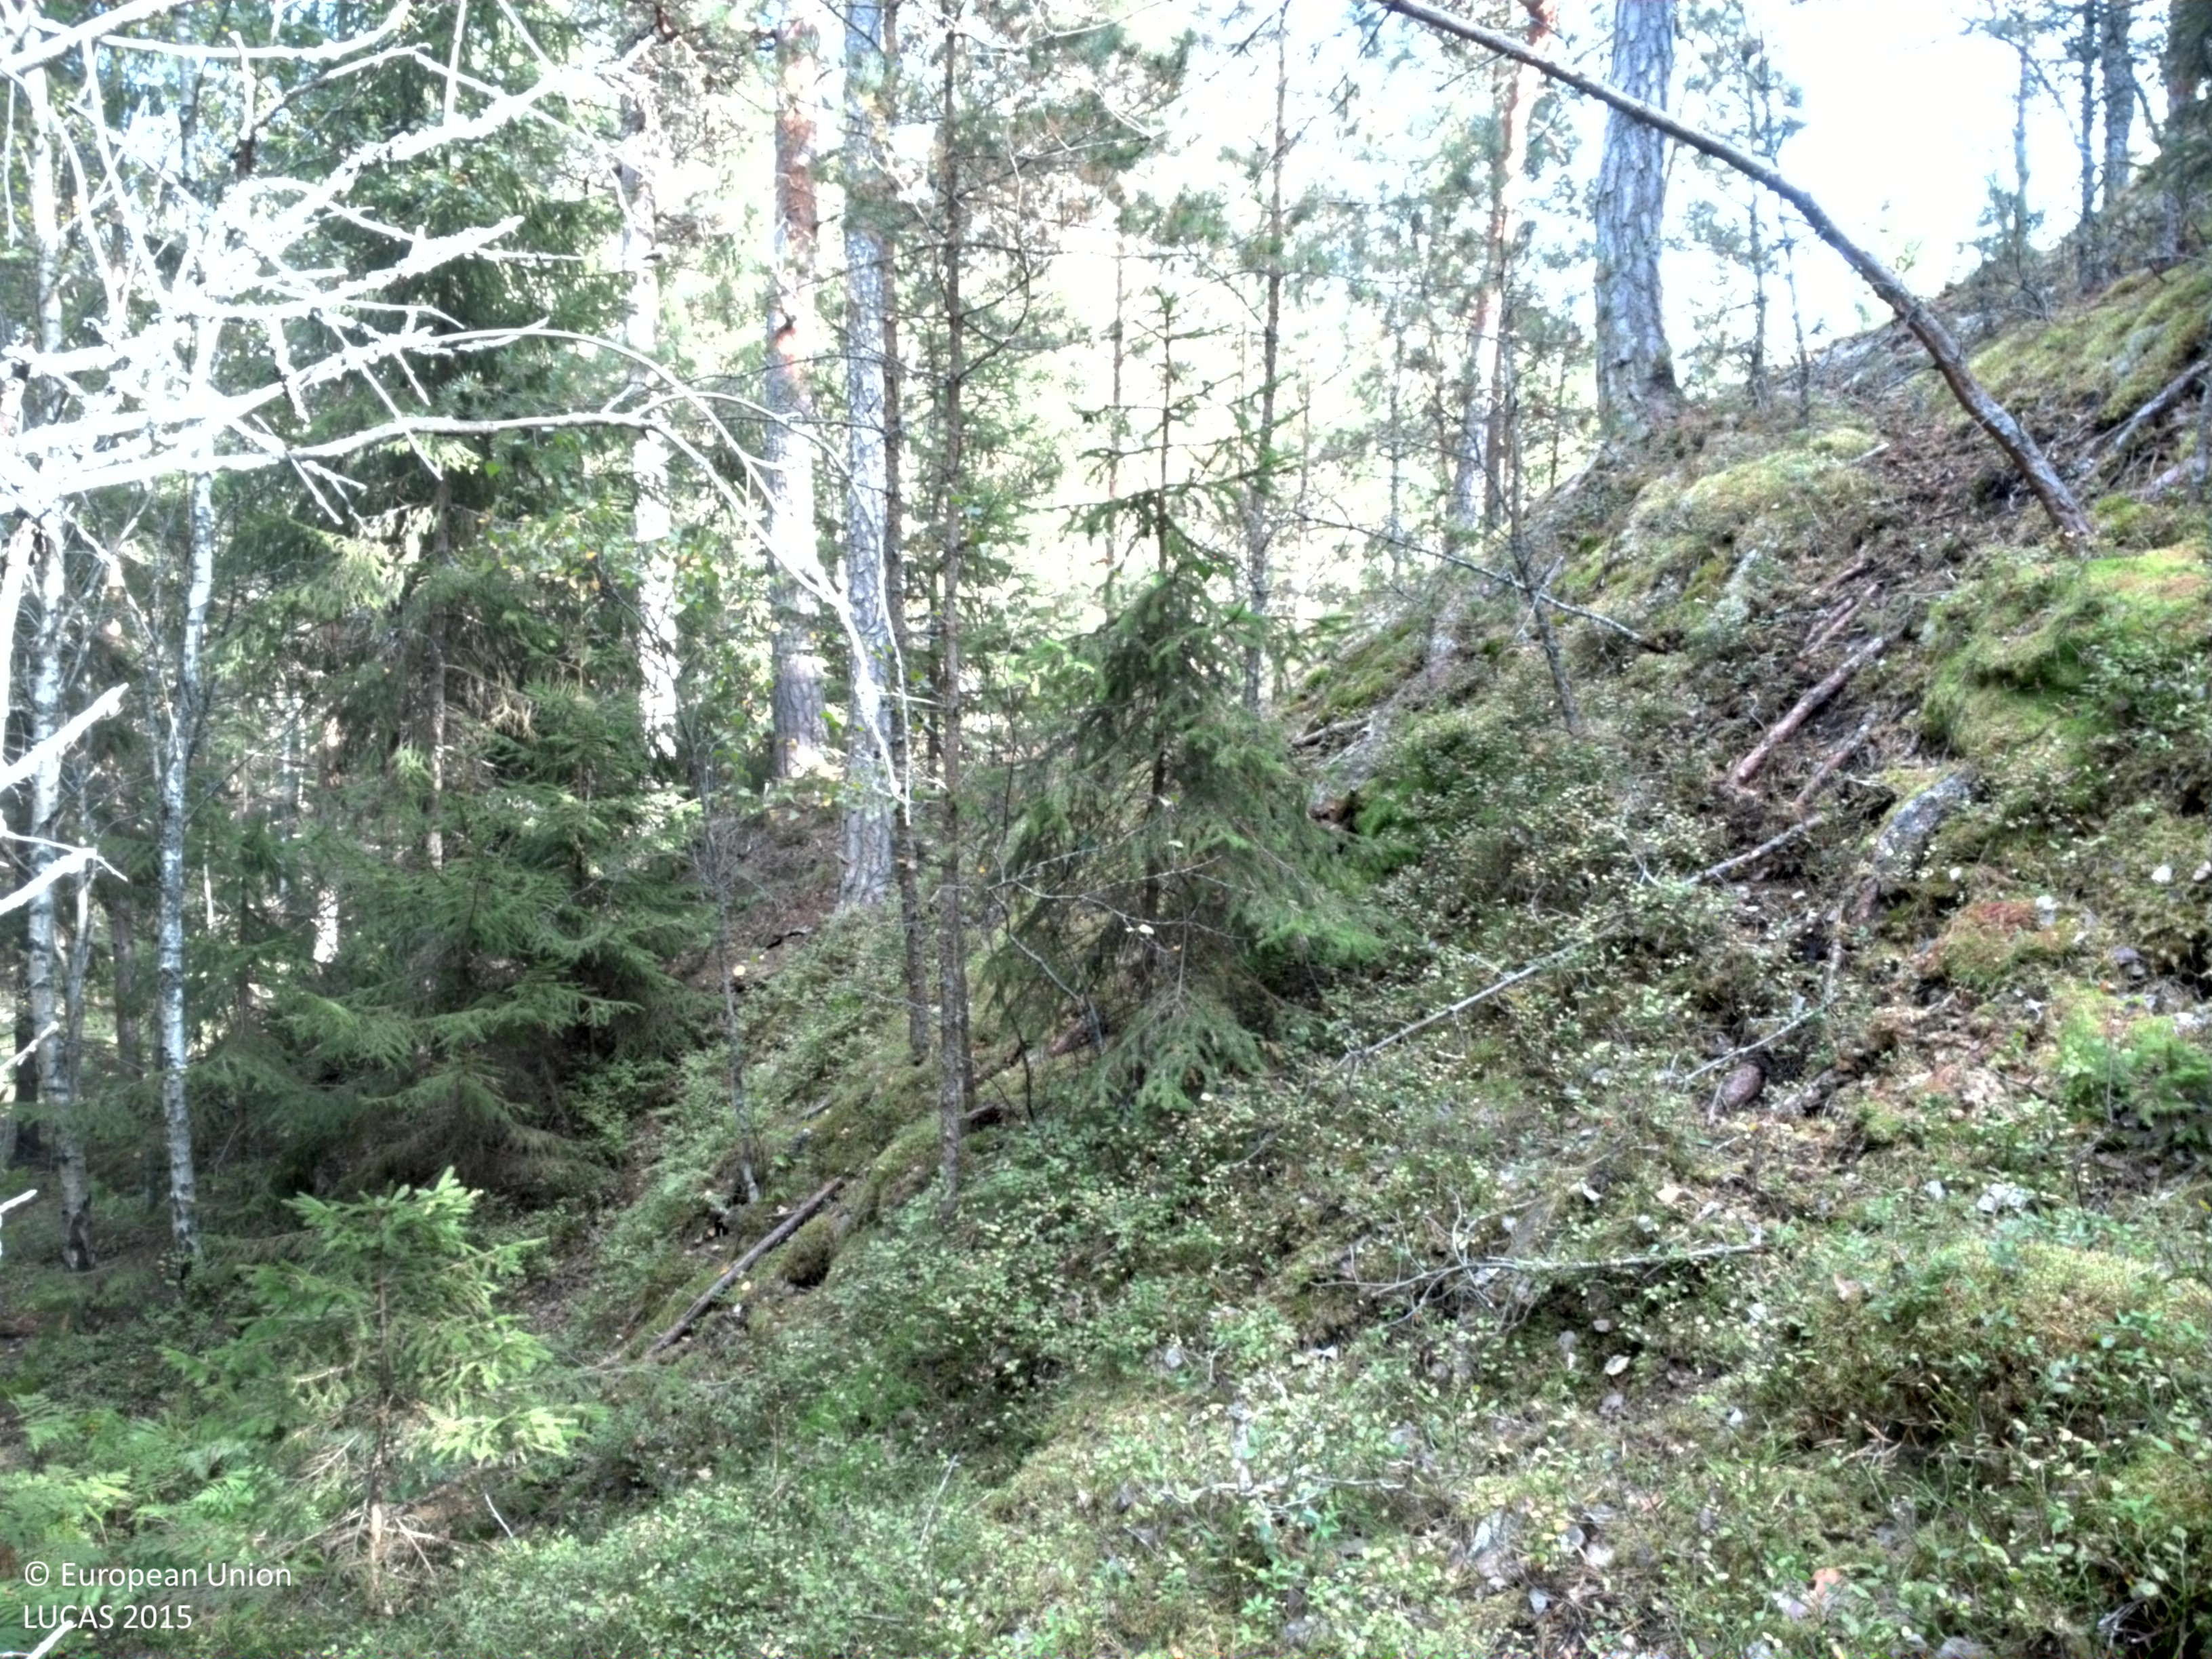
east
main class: Woodland
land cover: Pine dominated coniferous woodland
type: boreal forest
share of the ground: 50 - 75 %
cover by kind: coniferous forest trees 65 %, lichens and mosses 35 %
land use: Forestry
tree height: > 5 m
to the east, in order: Pine dominated coniferous woodland; Spruce dominated coniferous woodland; Ditches and canals; Spruce dominated coniferous woodland; Ditches and canals; Tracks; Spruce dominated coniferous woodland; Ditches and canals; Spruce dominated coniferous woodland; Ditches and canals; Spruce dominated coniferous woodland; Tracks; Spruce dominated coniferous woodland
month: September
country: SE
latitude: 59.3781
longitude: 18.5373
